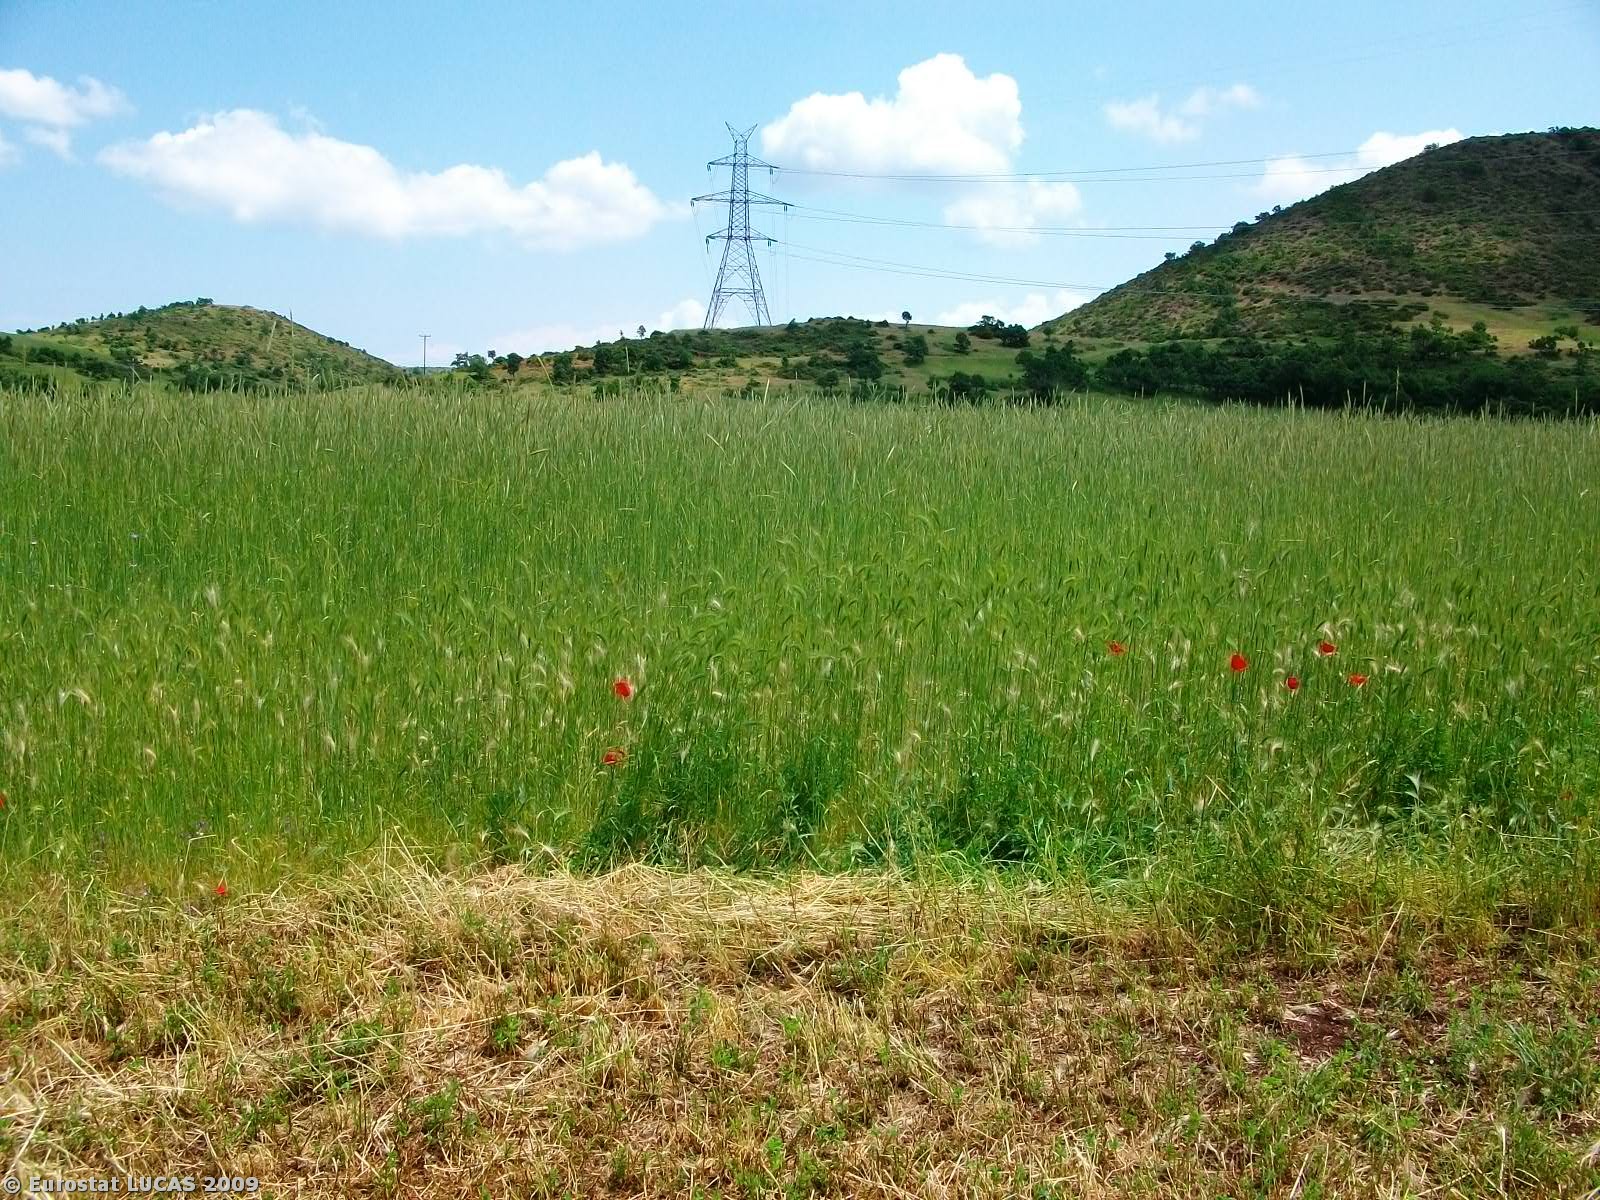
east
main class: Cropland
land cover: Lucerne
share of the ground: 25 - 50 %
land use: Agriculture (excluding fallow land and kitchen gardens)
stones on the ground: 10 - 25 %
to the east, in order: Lucerne; Grass margins; Barley; Grass margins; Spontaneously vegetated surfaces; Barley; Spontaneously vegetated surfaces; Electric lines; Spontaneously vegetated surfaces; Managed hedges; Spontaneously vegetated surfaces
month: May
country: GR
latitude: 40.1114
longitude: 21.7098
